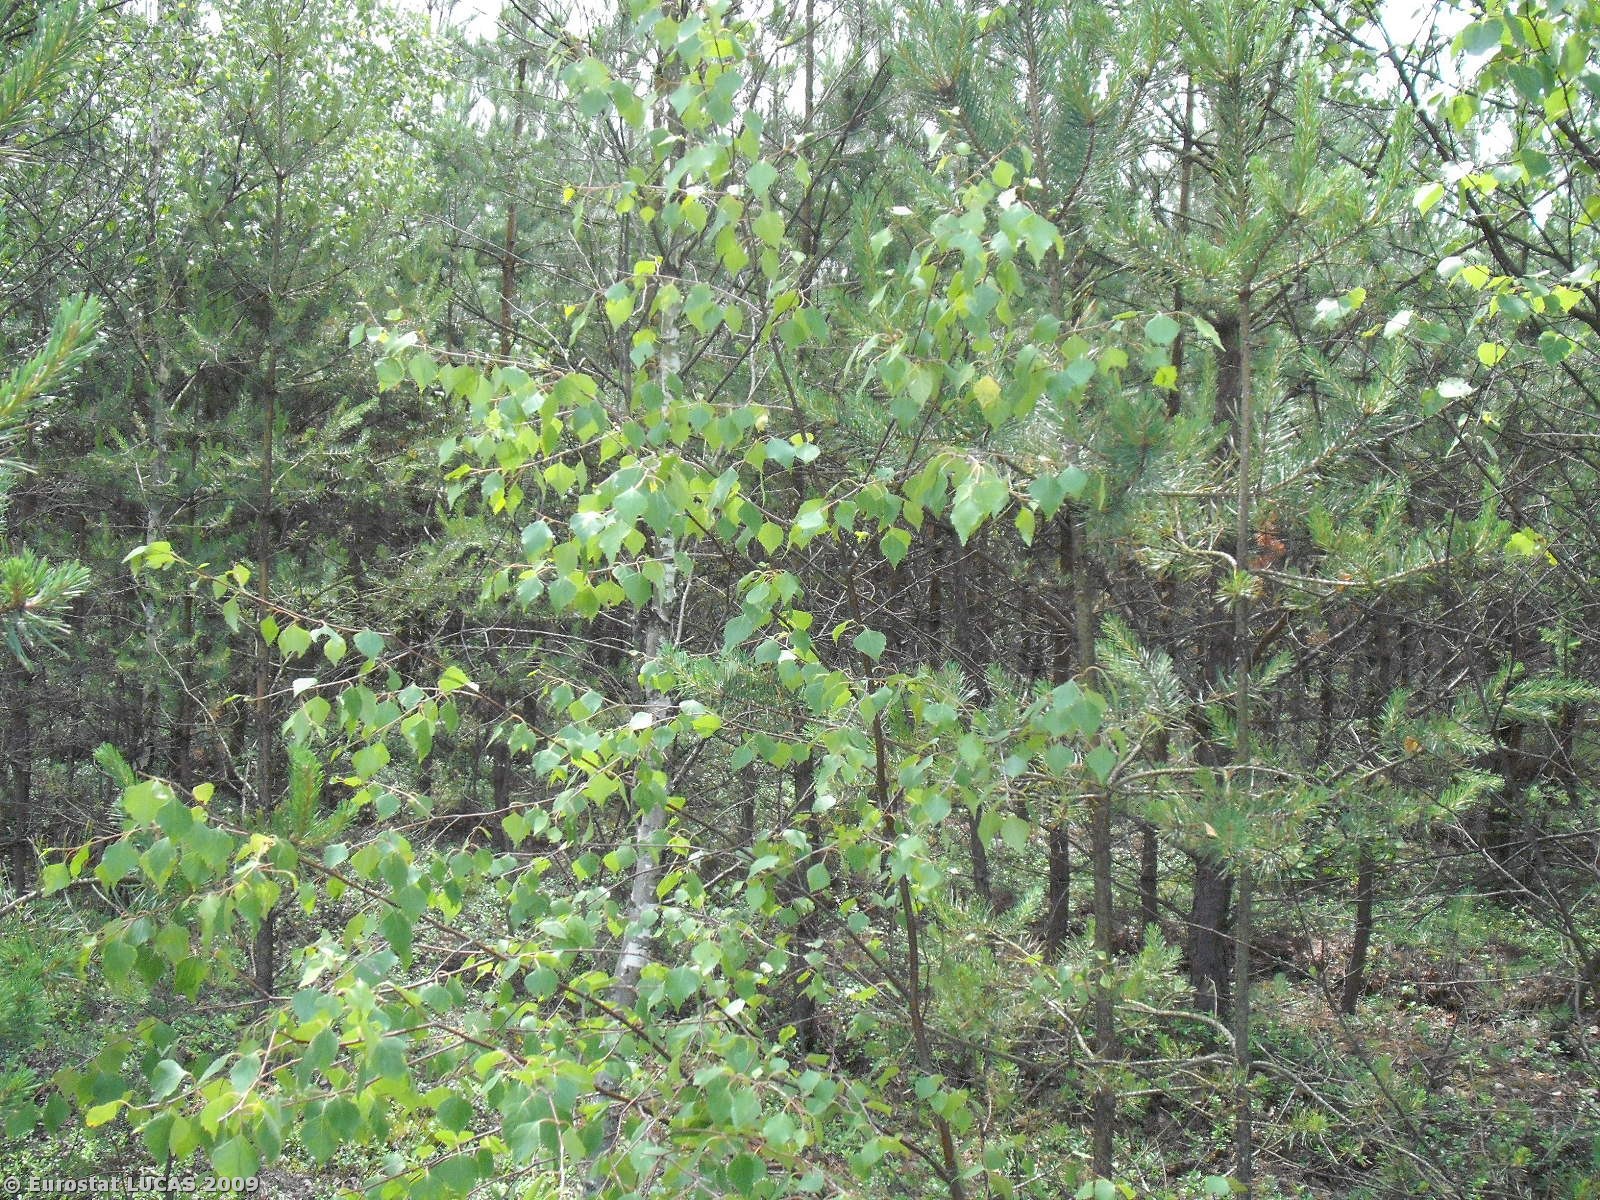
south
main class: Woodland
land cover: Coniferous woodland
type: hemiboreal forest and nemoral coniferous forest and mixed broadleaved-coniferous forest
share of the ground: > 75 %
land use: Forestry
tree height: > 5 m
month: June
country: PL
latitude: 51.2057
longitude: 20.4724
